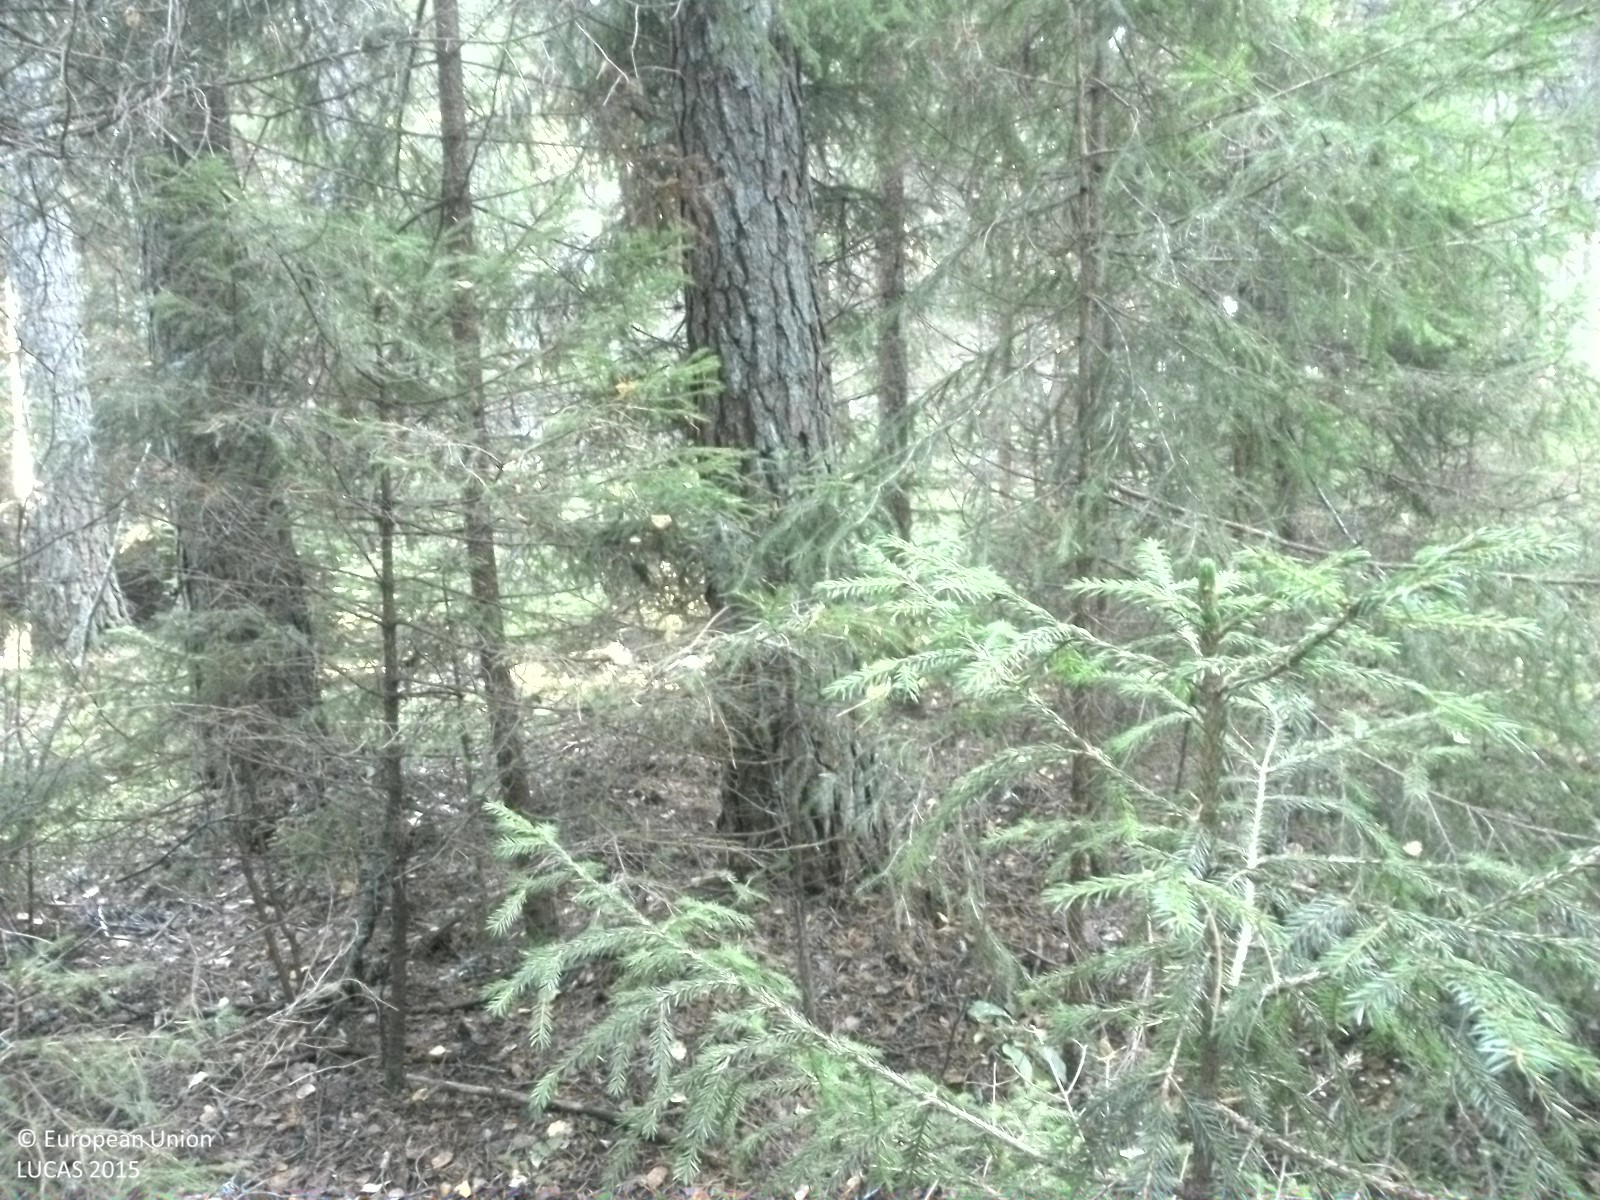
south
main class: Woodland
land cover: Spruce dominated mixed woodland
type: boreal forest
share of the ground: 50 - 75 %
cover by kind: coniferous forest trees 35 %, herbaceous plants 25 %, broadleaved forest trees 20 %, lichens and mosses 20 %
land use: Forestry
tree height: > 5 m
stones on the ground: < 10 %
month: September
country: SE
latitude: 58.7183
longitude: 16.7472
